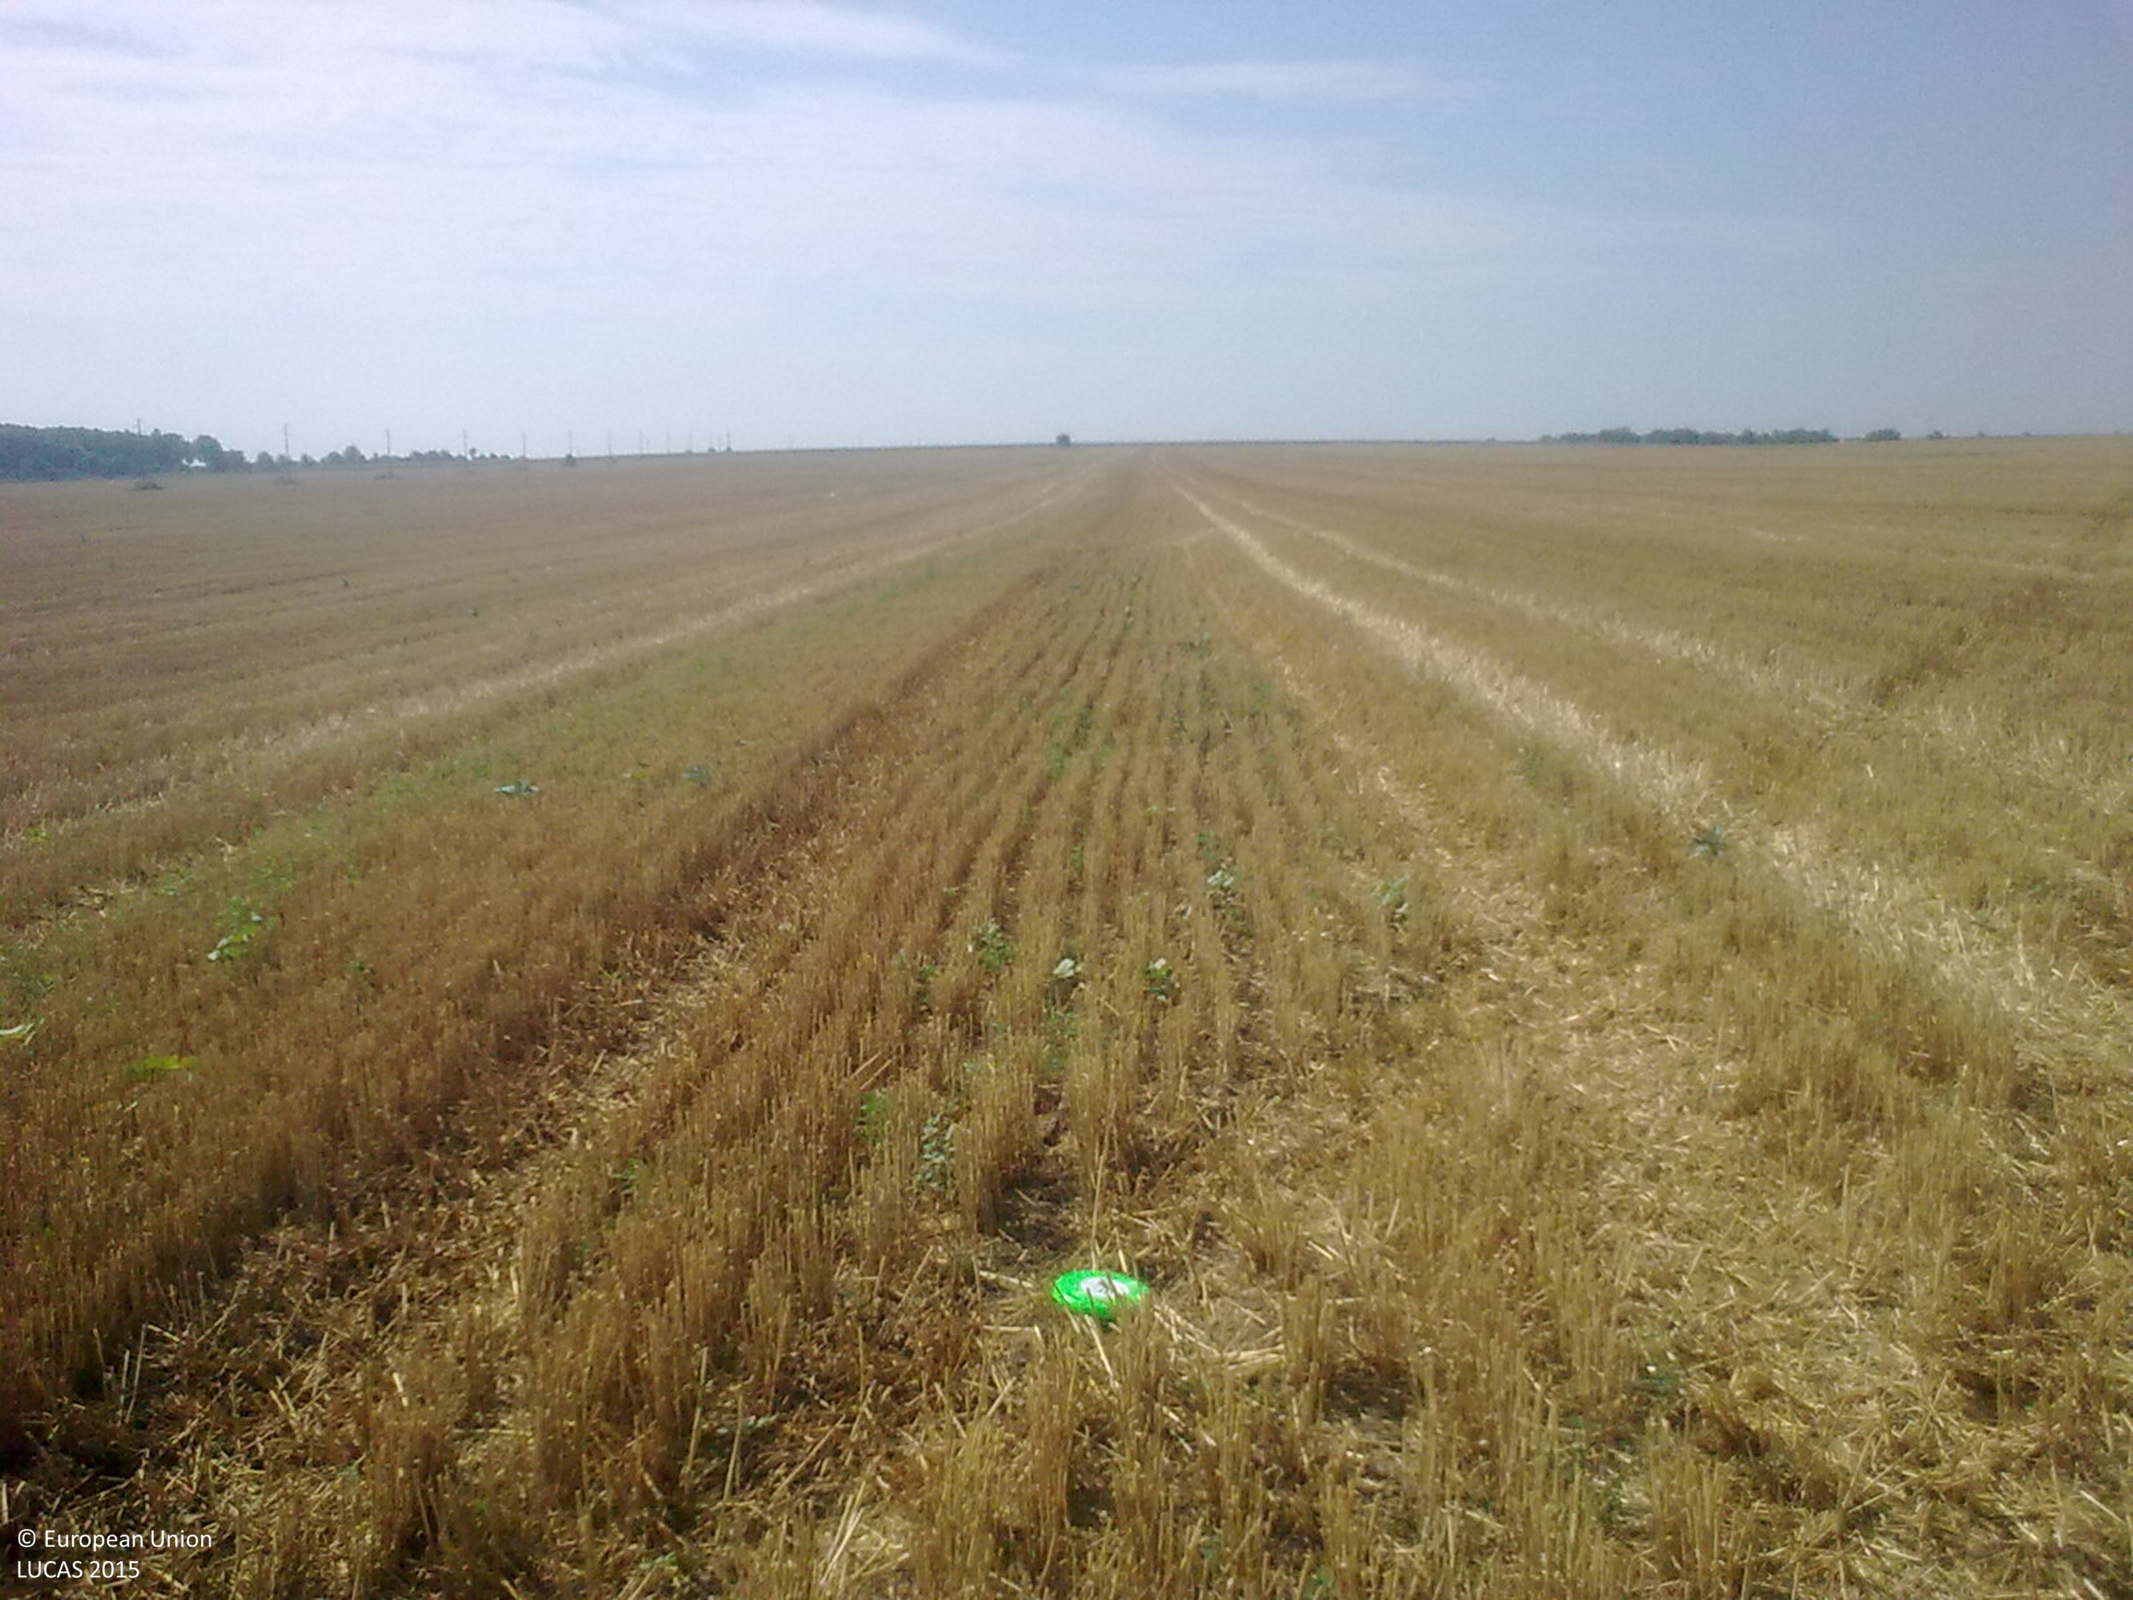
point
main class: Cropland
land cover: Common wheat
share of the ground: 50 - 75 %
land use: Agriculture (excluding fallow land and kitchen gardens)
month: July
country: BG
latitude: 43.7870
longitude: 26.2946
